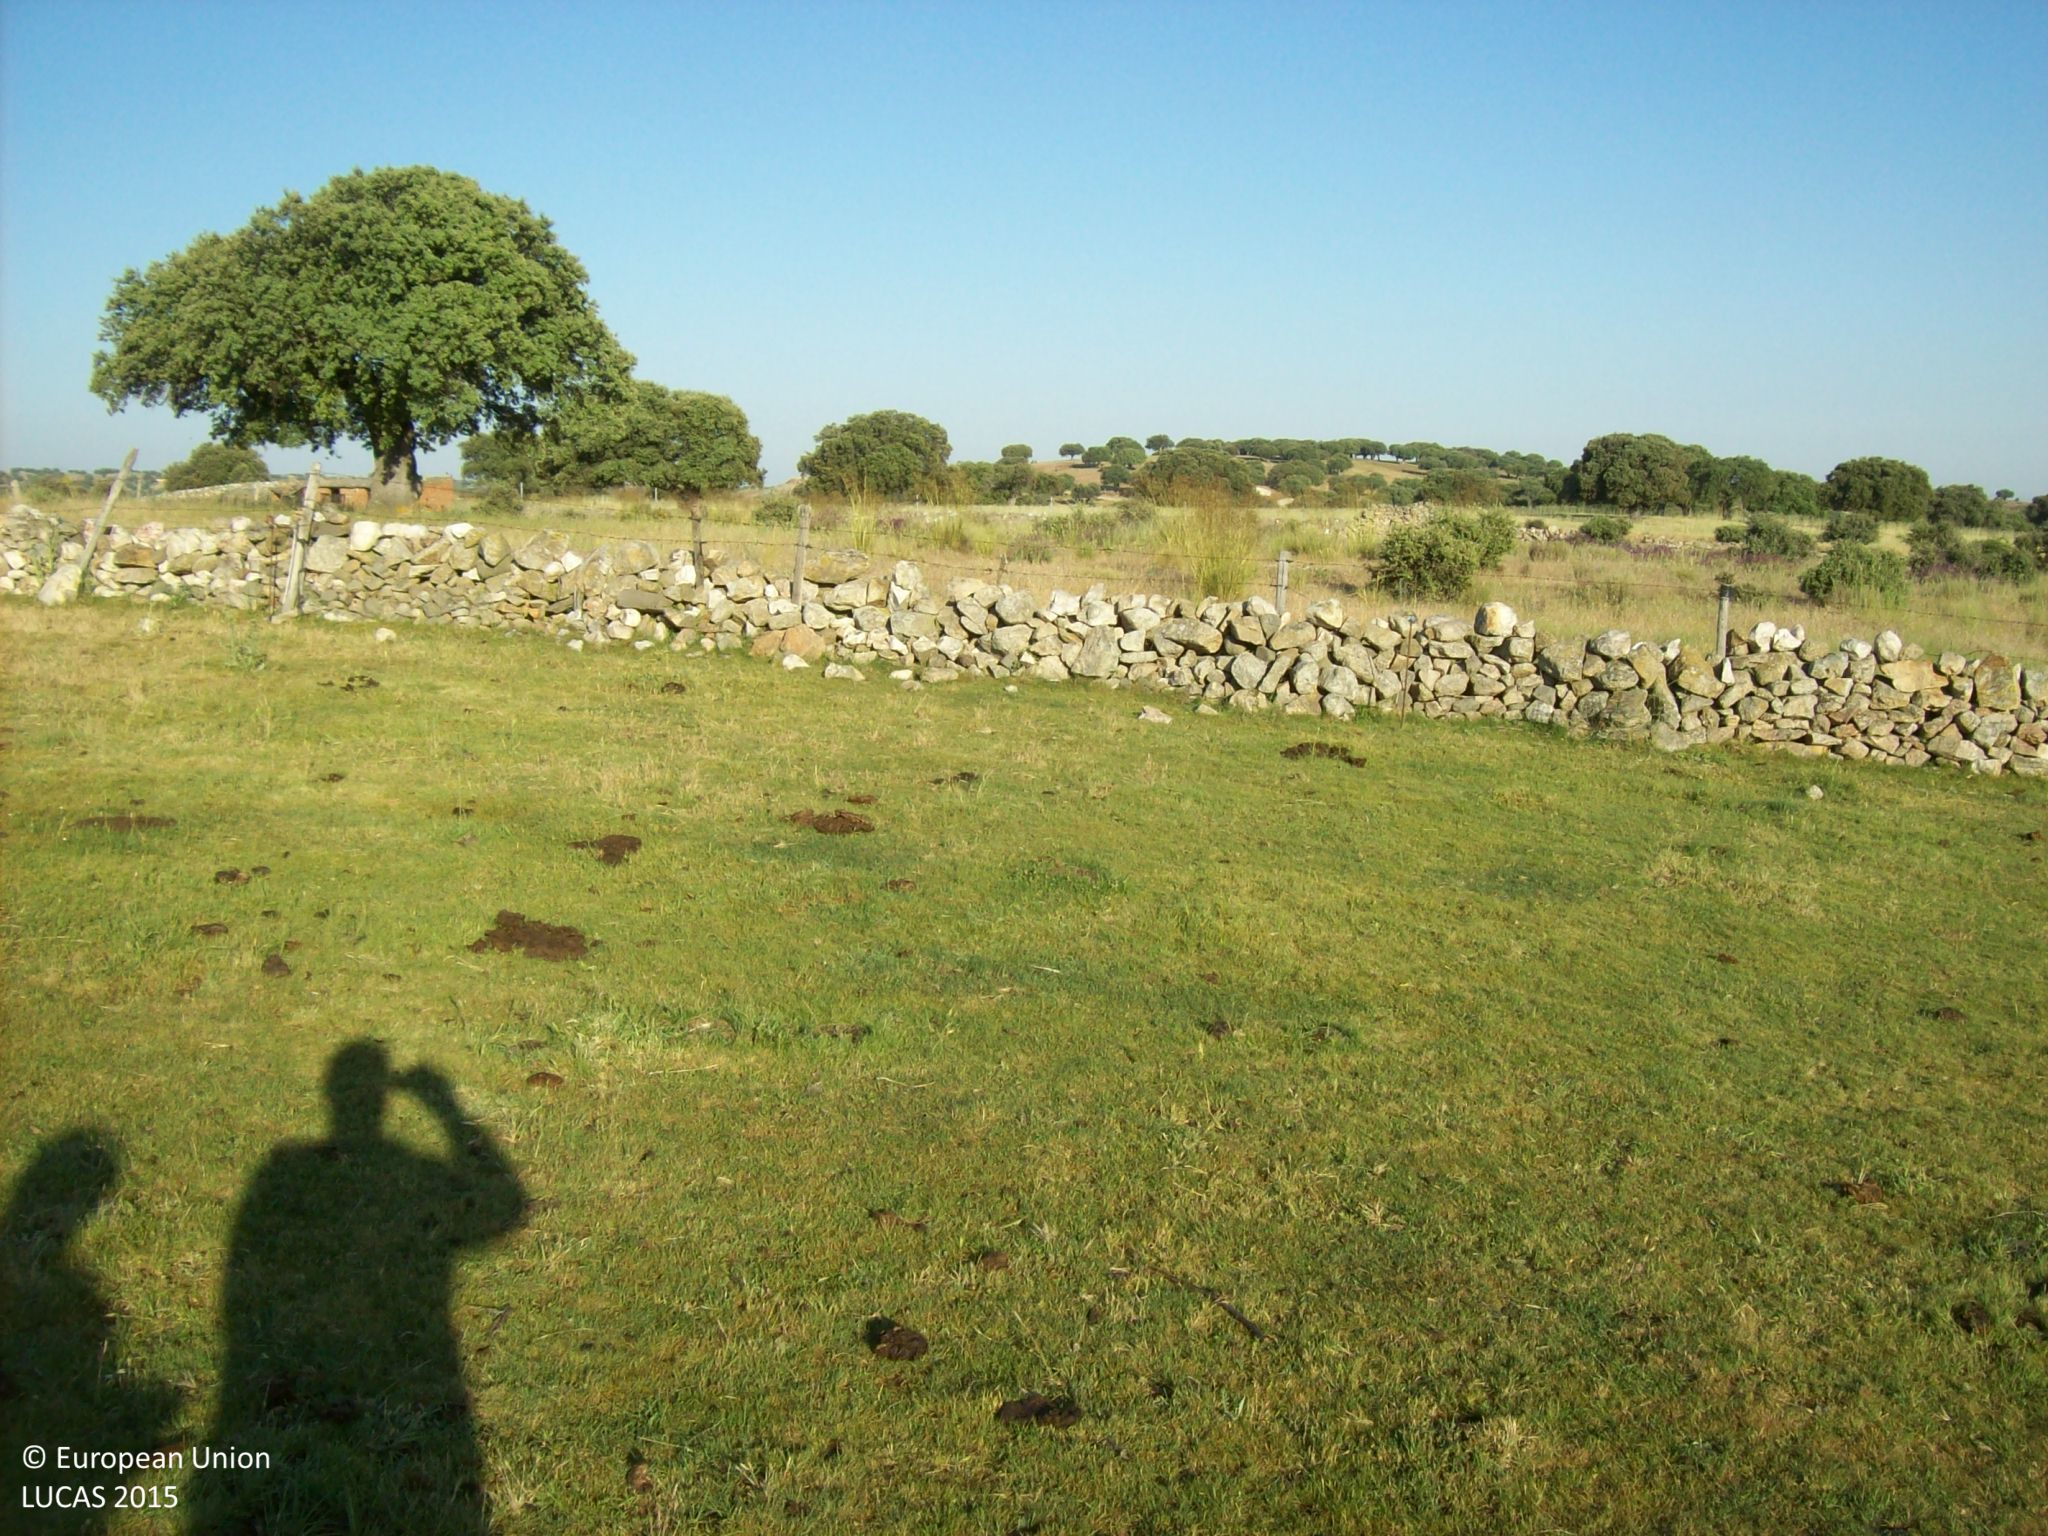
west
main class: Grassland
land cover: Grassland without tree/shrub cover
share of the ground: > 75 %
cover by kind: herbaceous plants 100 %
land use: Agriculture (excluding fallow land and kitchen gardens)
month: May
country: ES
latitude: 40.7591
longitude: -5.1197
